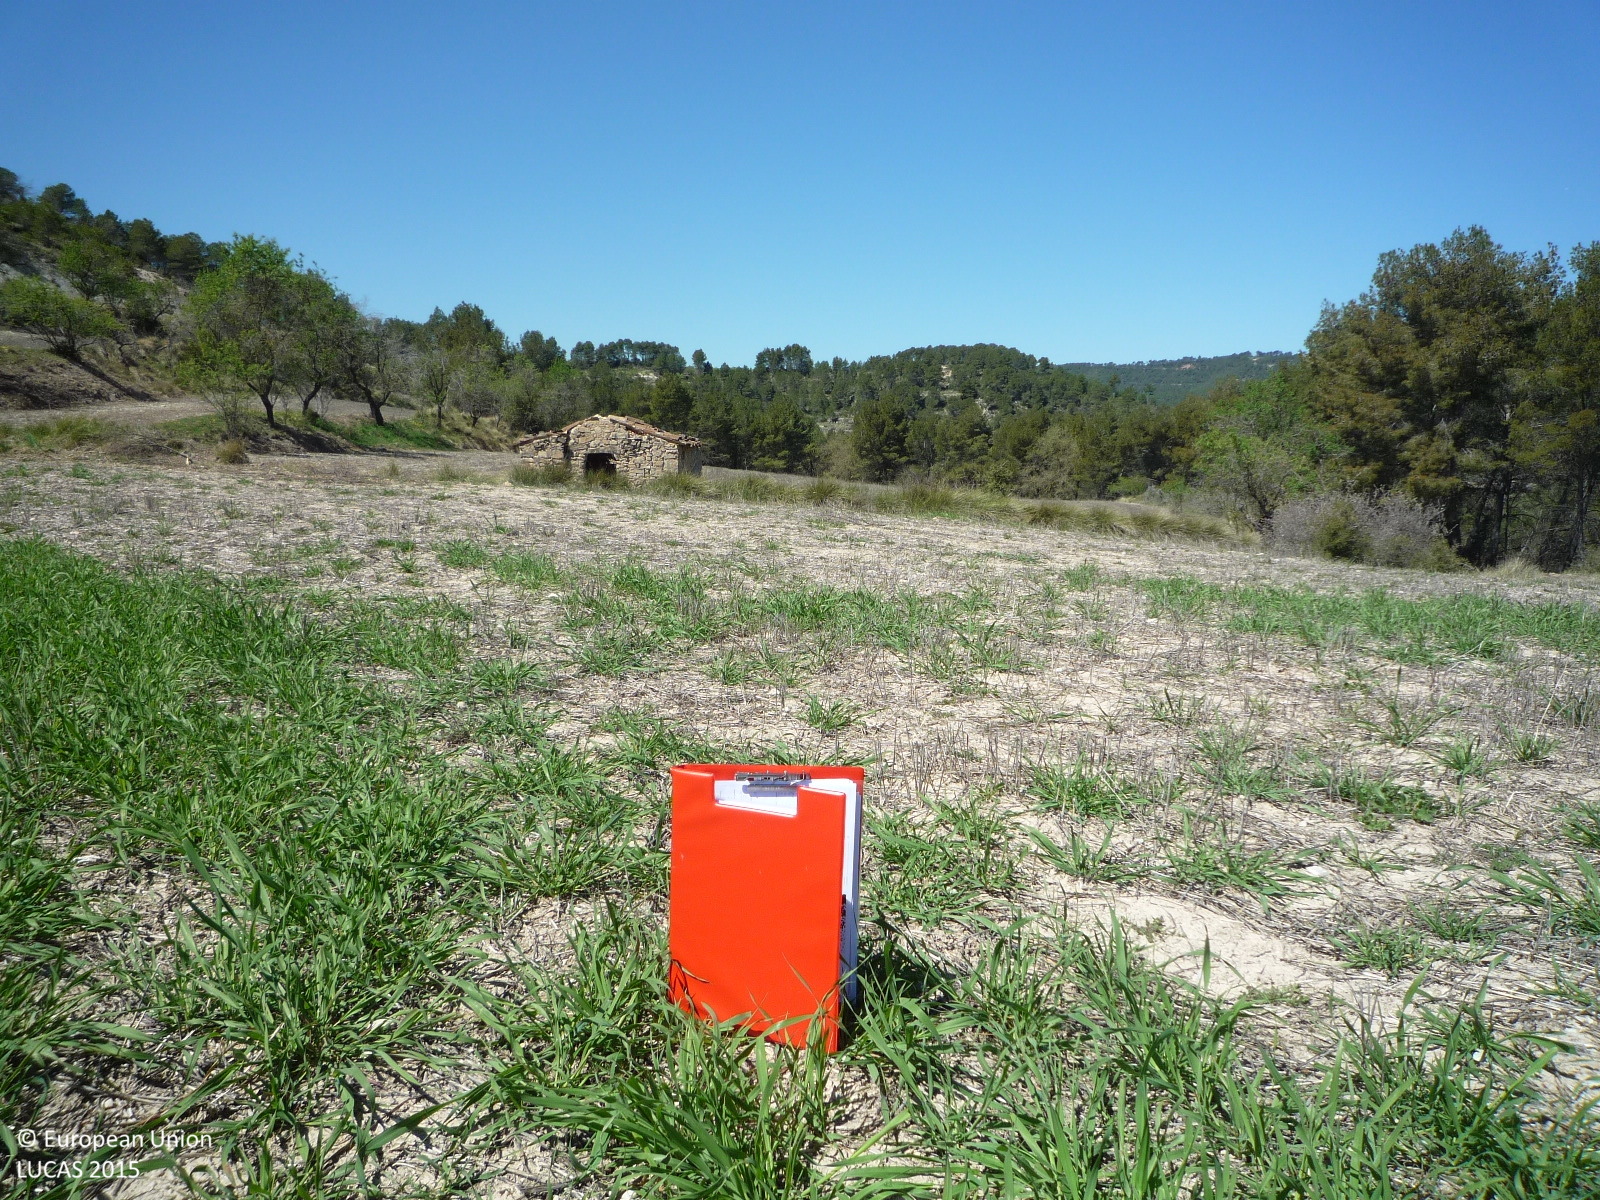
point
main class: Grassland
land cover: Spontaneously vegetated surfaces
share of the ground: > 75 %
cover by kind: herbaceous plants 85 %, unconsolidated bare surface 15 %
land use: Agriculture (excluding fallow land and kitchen gardens)
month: April
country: ES
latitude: 41.5510
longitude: 1.4913
